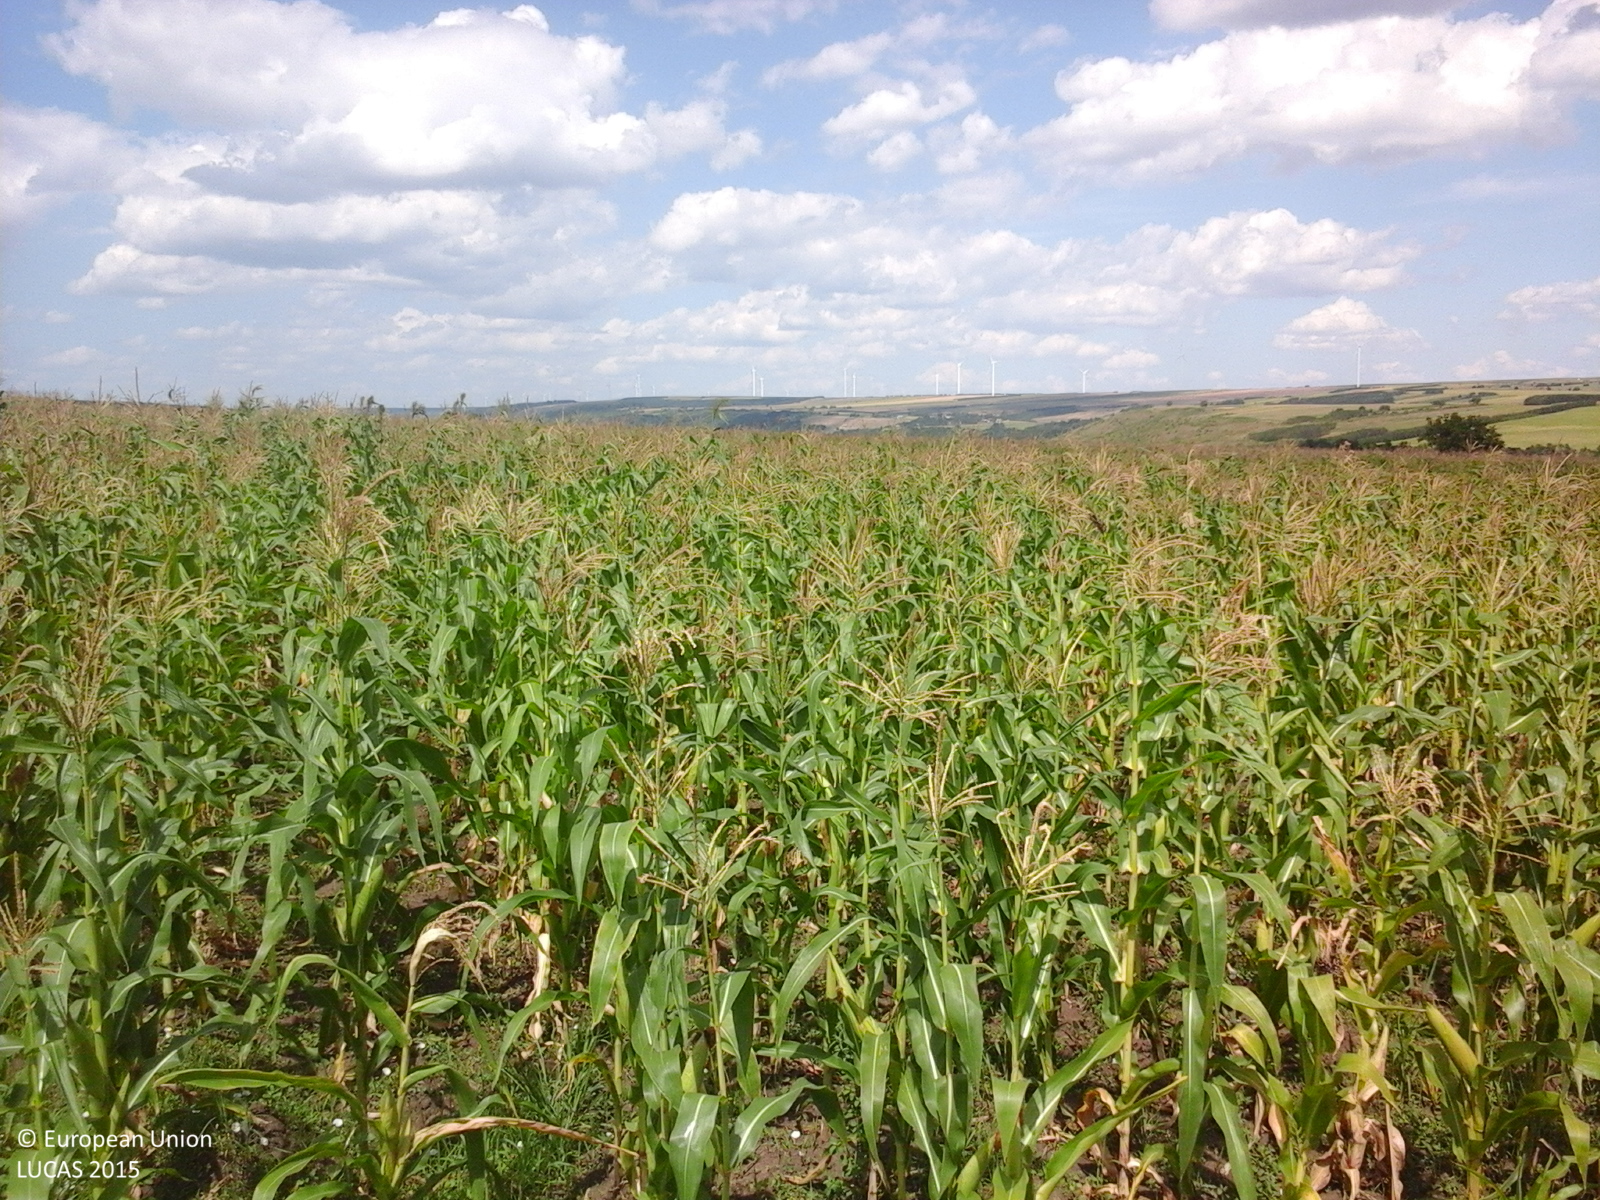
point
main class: Cropland
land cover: Maize
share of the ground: > 75 %
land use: Agriculture (excluding fallow land and kitchen gardens)
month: July
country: RO
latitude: 46.4486
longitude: 27.8921
